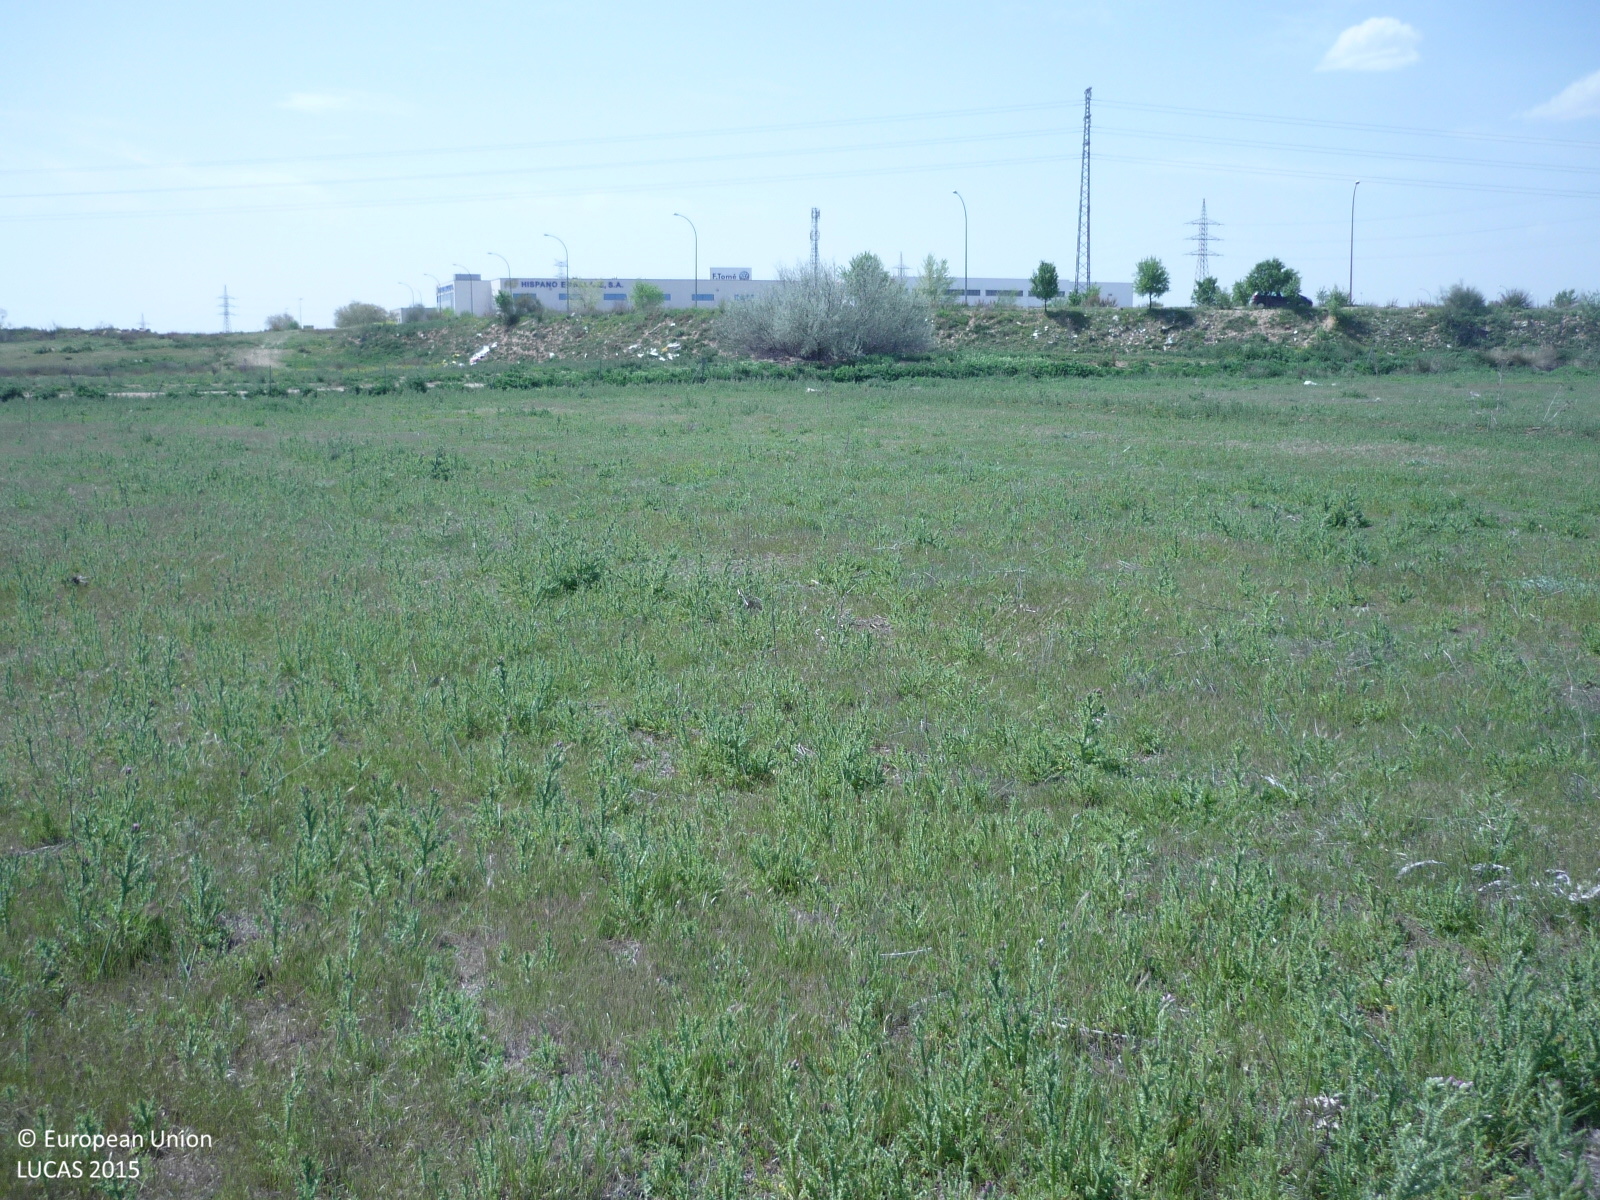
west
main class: Grassland
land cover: Spontaneously vegetated surfaces
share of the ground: > 75 %
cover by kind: herbaceous plants 90 %, consolidated bare surface 10 %
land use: Fallow land
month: April
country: ES
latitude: 40.4997
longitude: -3.3799
